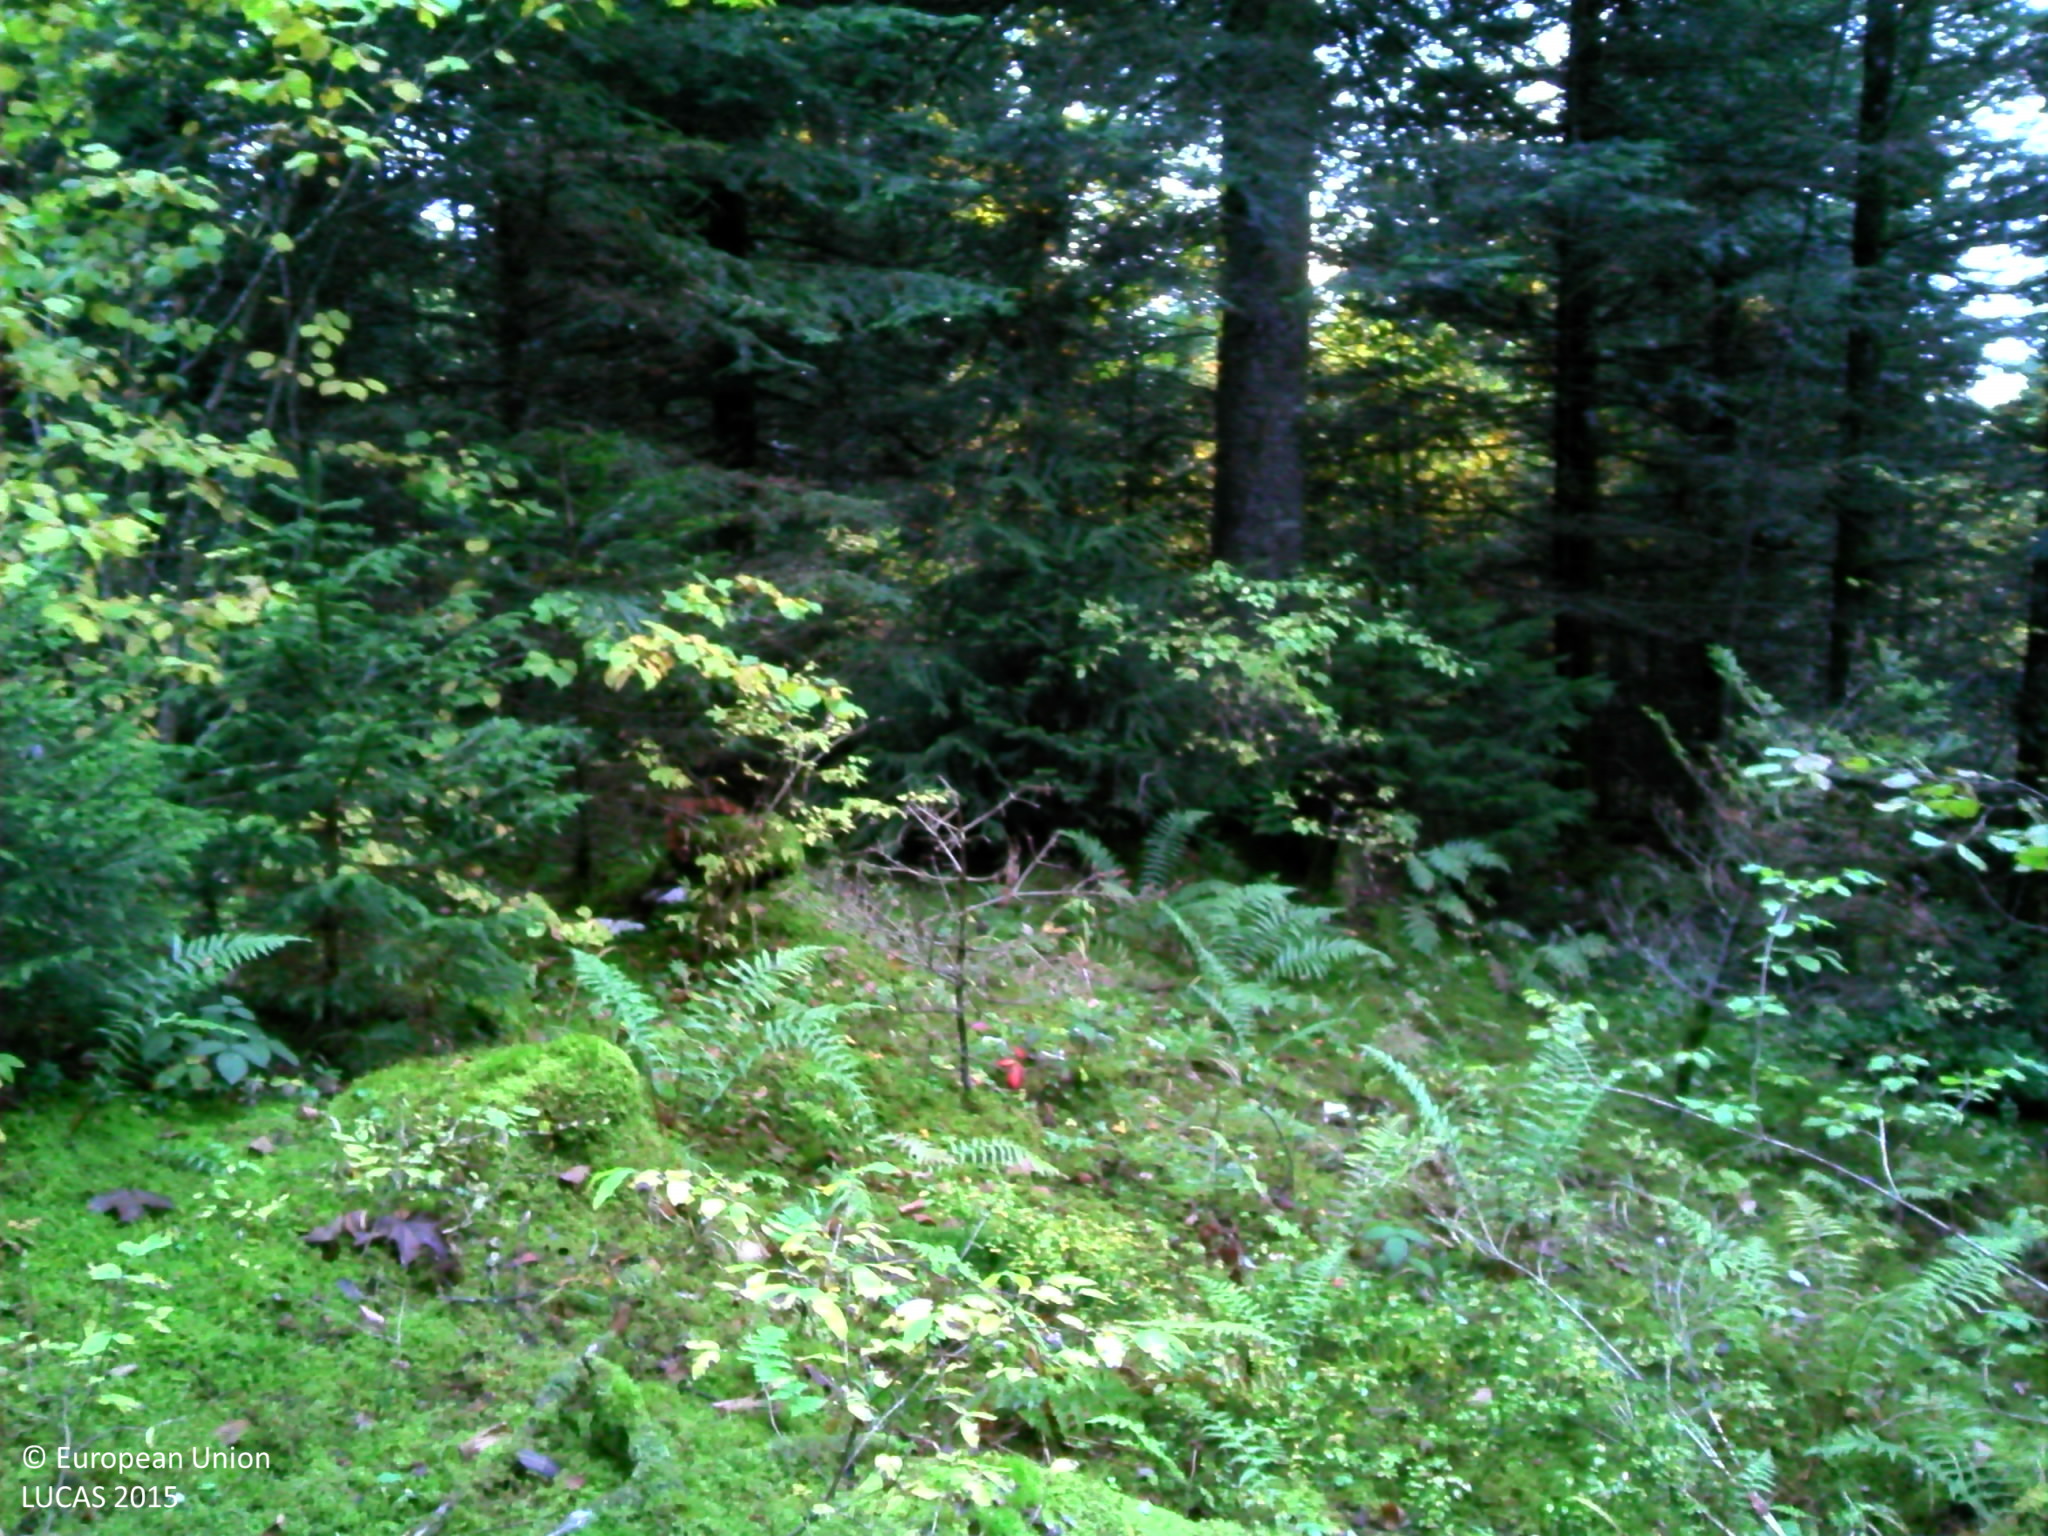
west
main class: Woodland
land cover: Spruce dominated mixed woodland
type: hemiboreal forest and nemoral coniferous forest and mixed broadleaved-coniferous forest
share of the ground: > 75 %
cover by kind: coniferous forest trees 40 %, broadleaved forest trees 40 %, shrubs 20 %
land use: Forestry
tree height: > 5 m
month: October
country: FR
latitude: 46.7927
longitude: 6.3213
